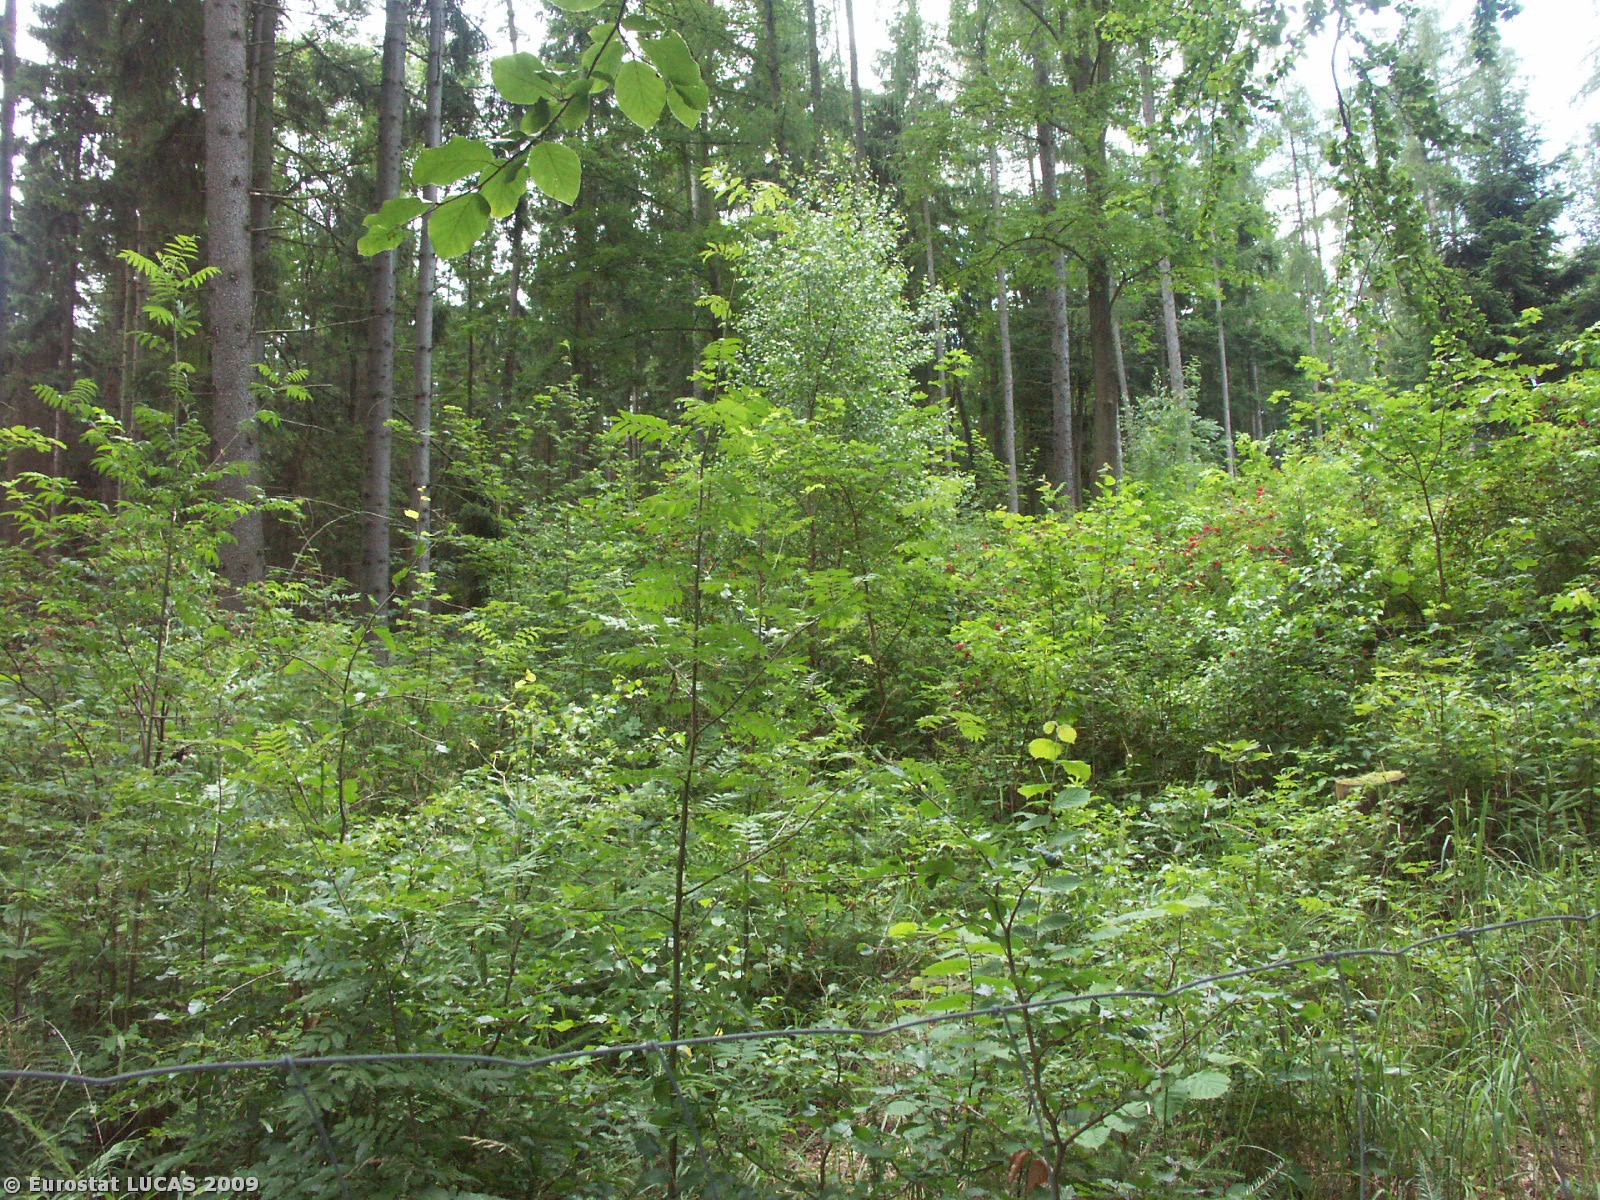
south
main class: Woodland
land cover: Mixed woodland
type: hemiboreal forest and nemoral coniferous forest and mixed broadleaved-coniferous forest
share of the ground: > 75 %
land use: Forestry
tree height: > 5 m
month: July
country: CZ
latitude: 49.8586
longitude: 17.5939
